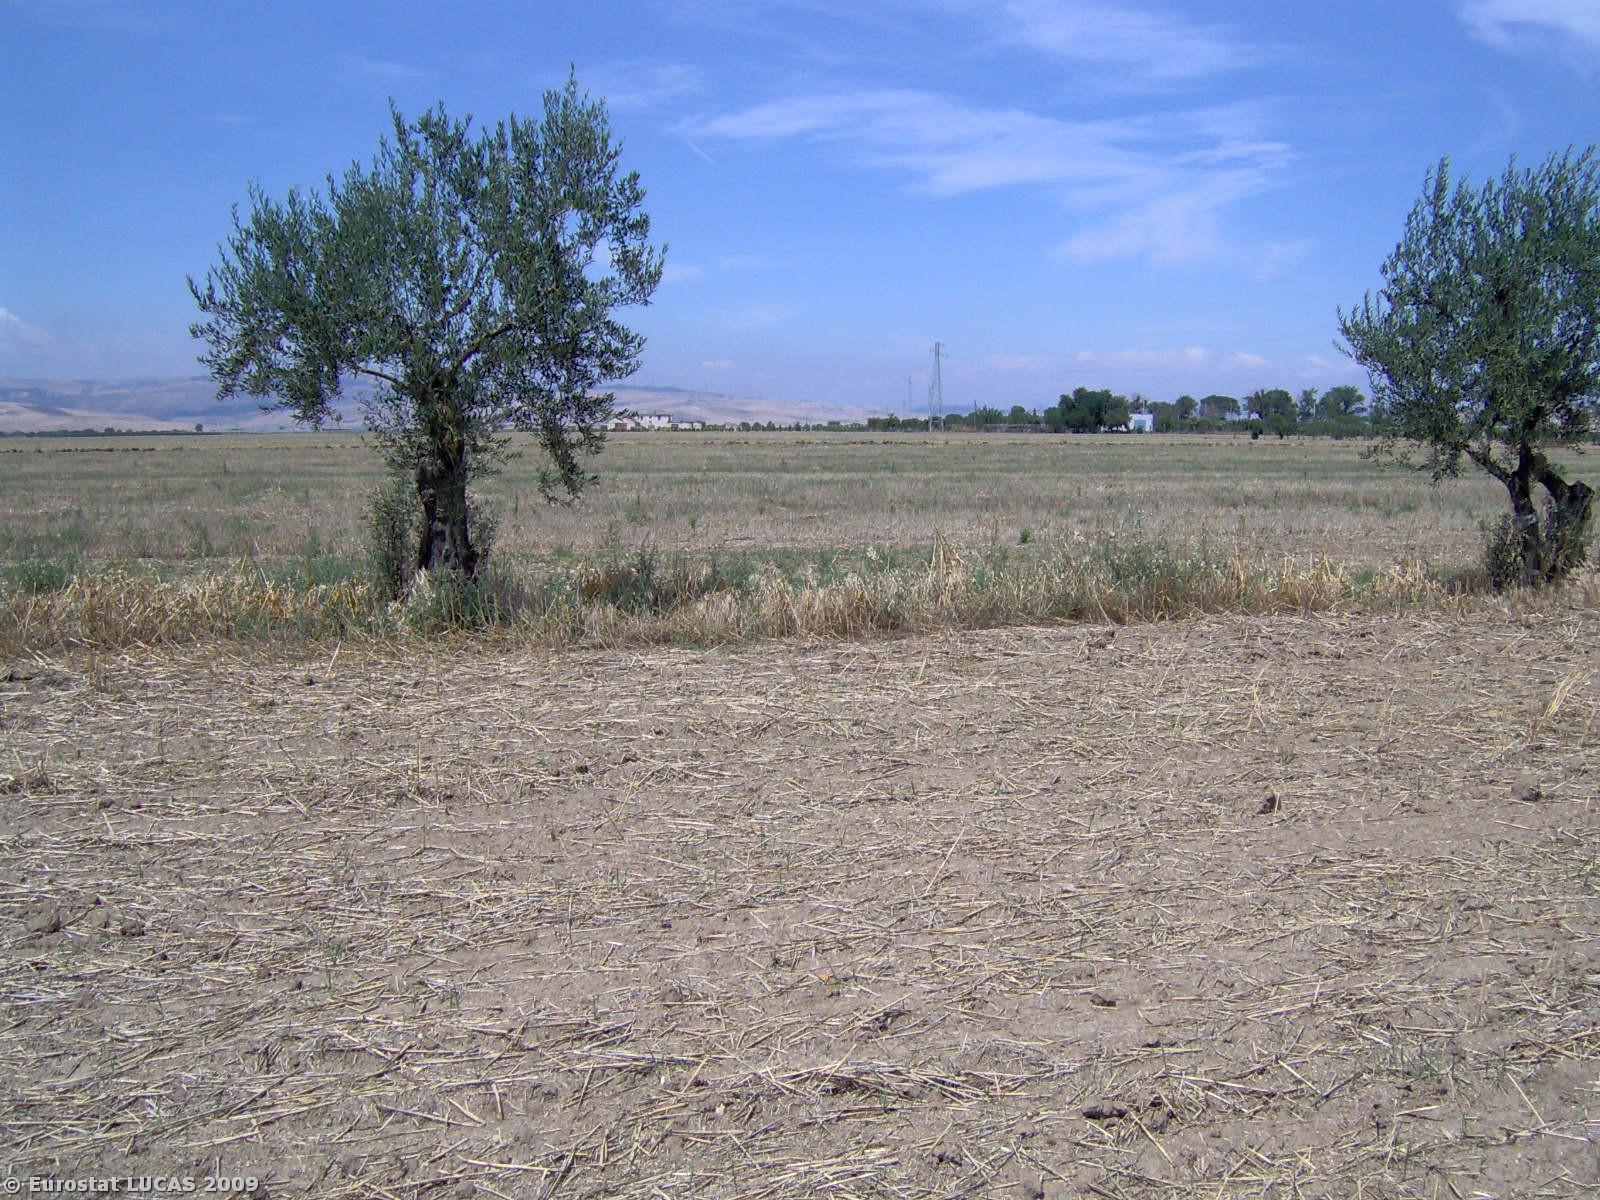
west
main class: Cropland
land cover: Durum wheat
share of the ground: < 10 %
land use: Agriculture (excluding fallow land and kitchen gardens)
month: July
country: IT
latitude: 41.1011
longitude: 15.6596
